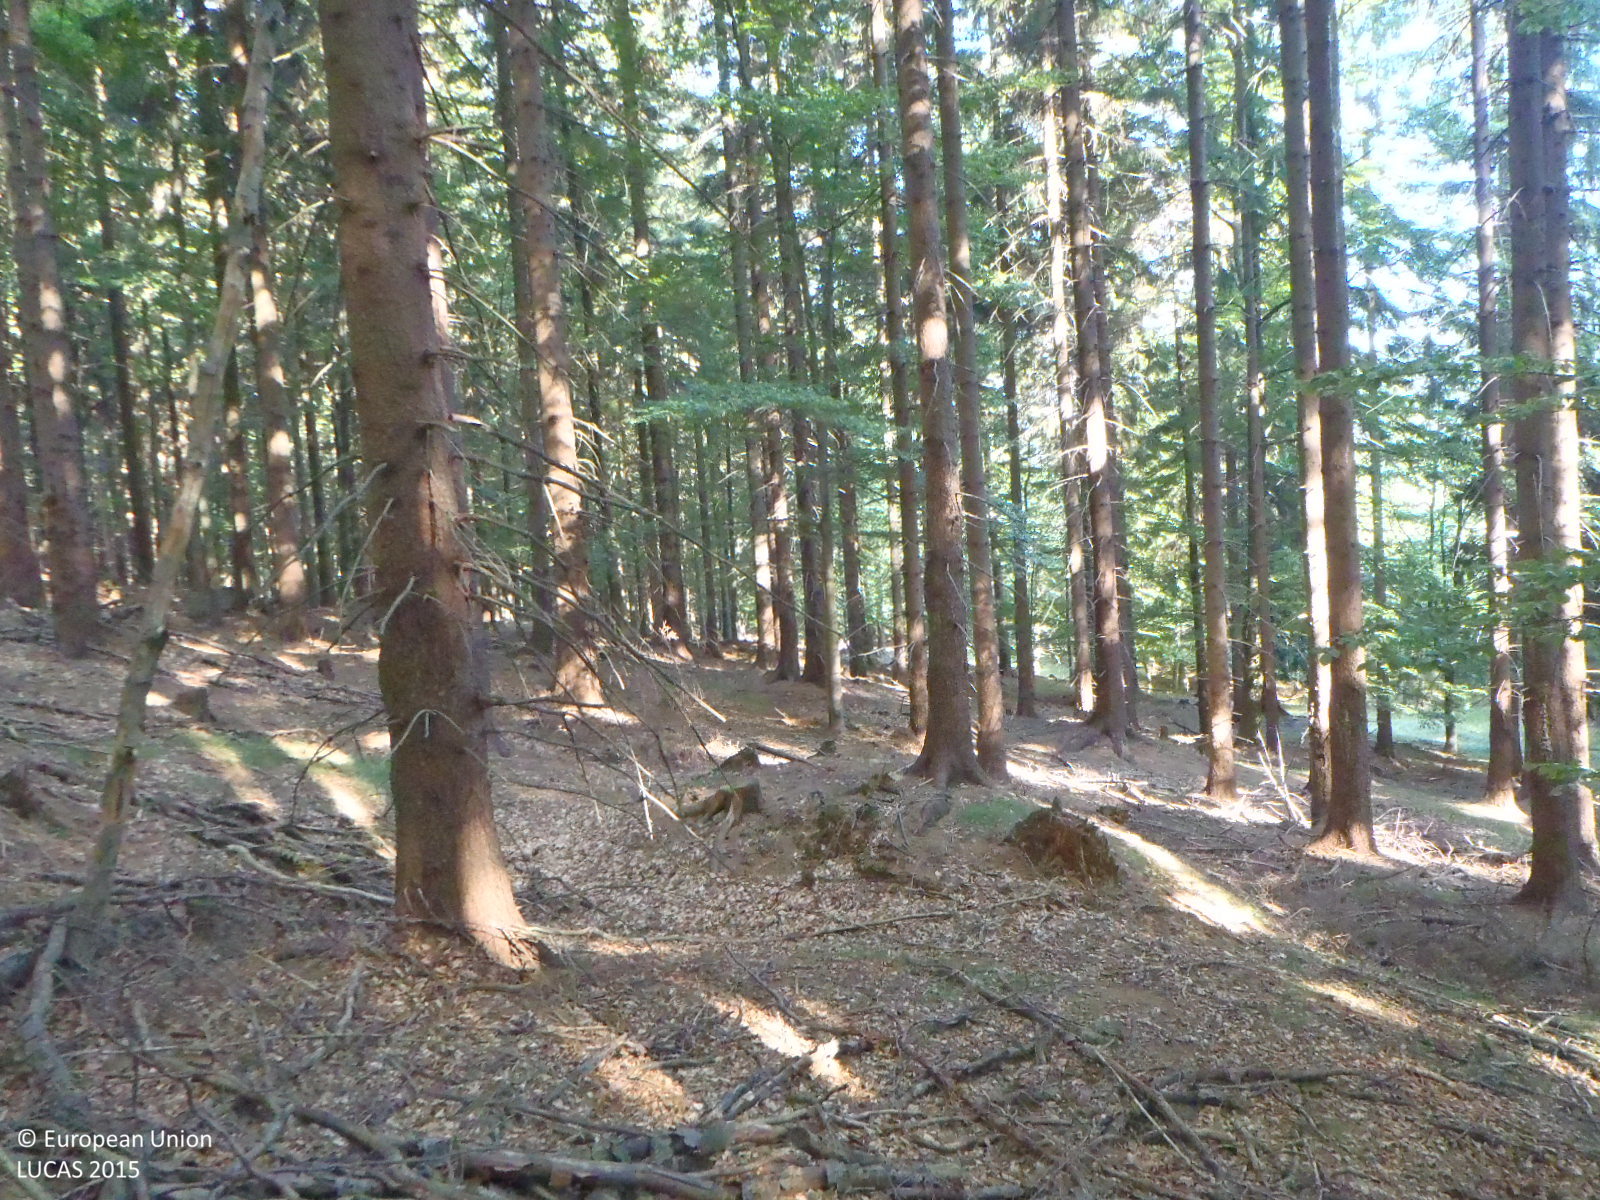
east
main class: Woodland
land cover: Spruce dominated mixed woodland
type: hemiboreal forest and nemoral coniferous forest and mixed broadleaved-coniferous forest
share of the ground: > 75 %
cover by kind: coniferous forest trees 50 %, broadleaved forest trees 50 %
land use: Forestry
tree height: > 5 m
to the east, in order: Spruce dominated mixed woodland; Tracks; Grassland with sparse tree/shrub cover; Spruce dominated coniferous woodland
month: August
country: CZ
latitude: 50.8315
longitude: 14.5596
